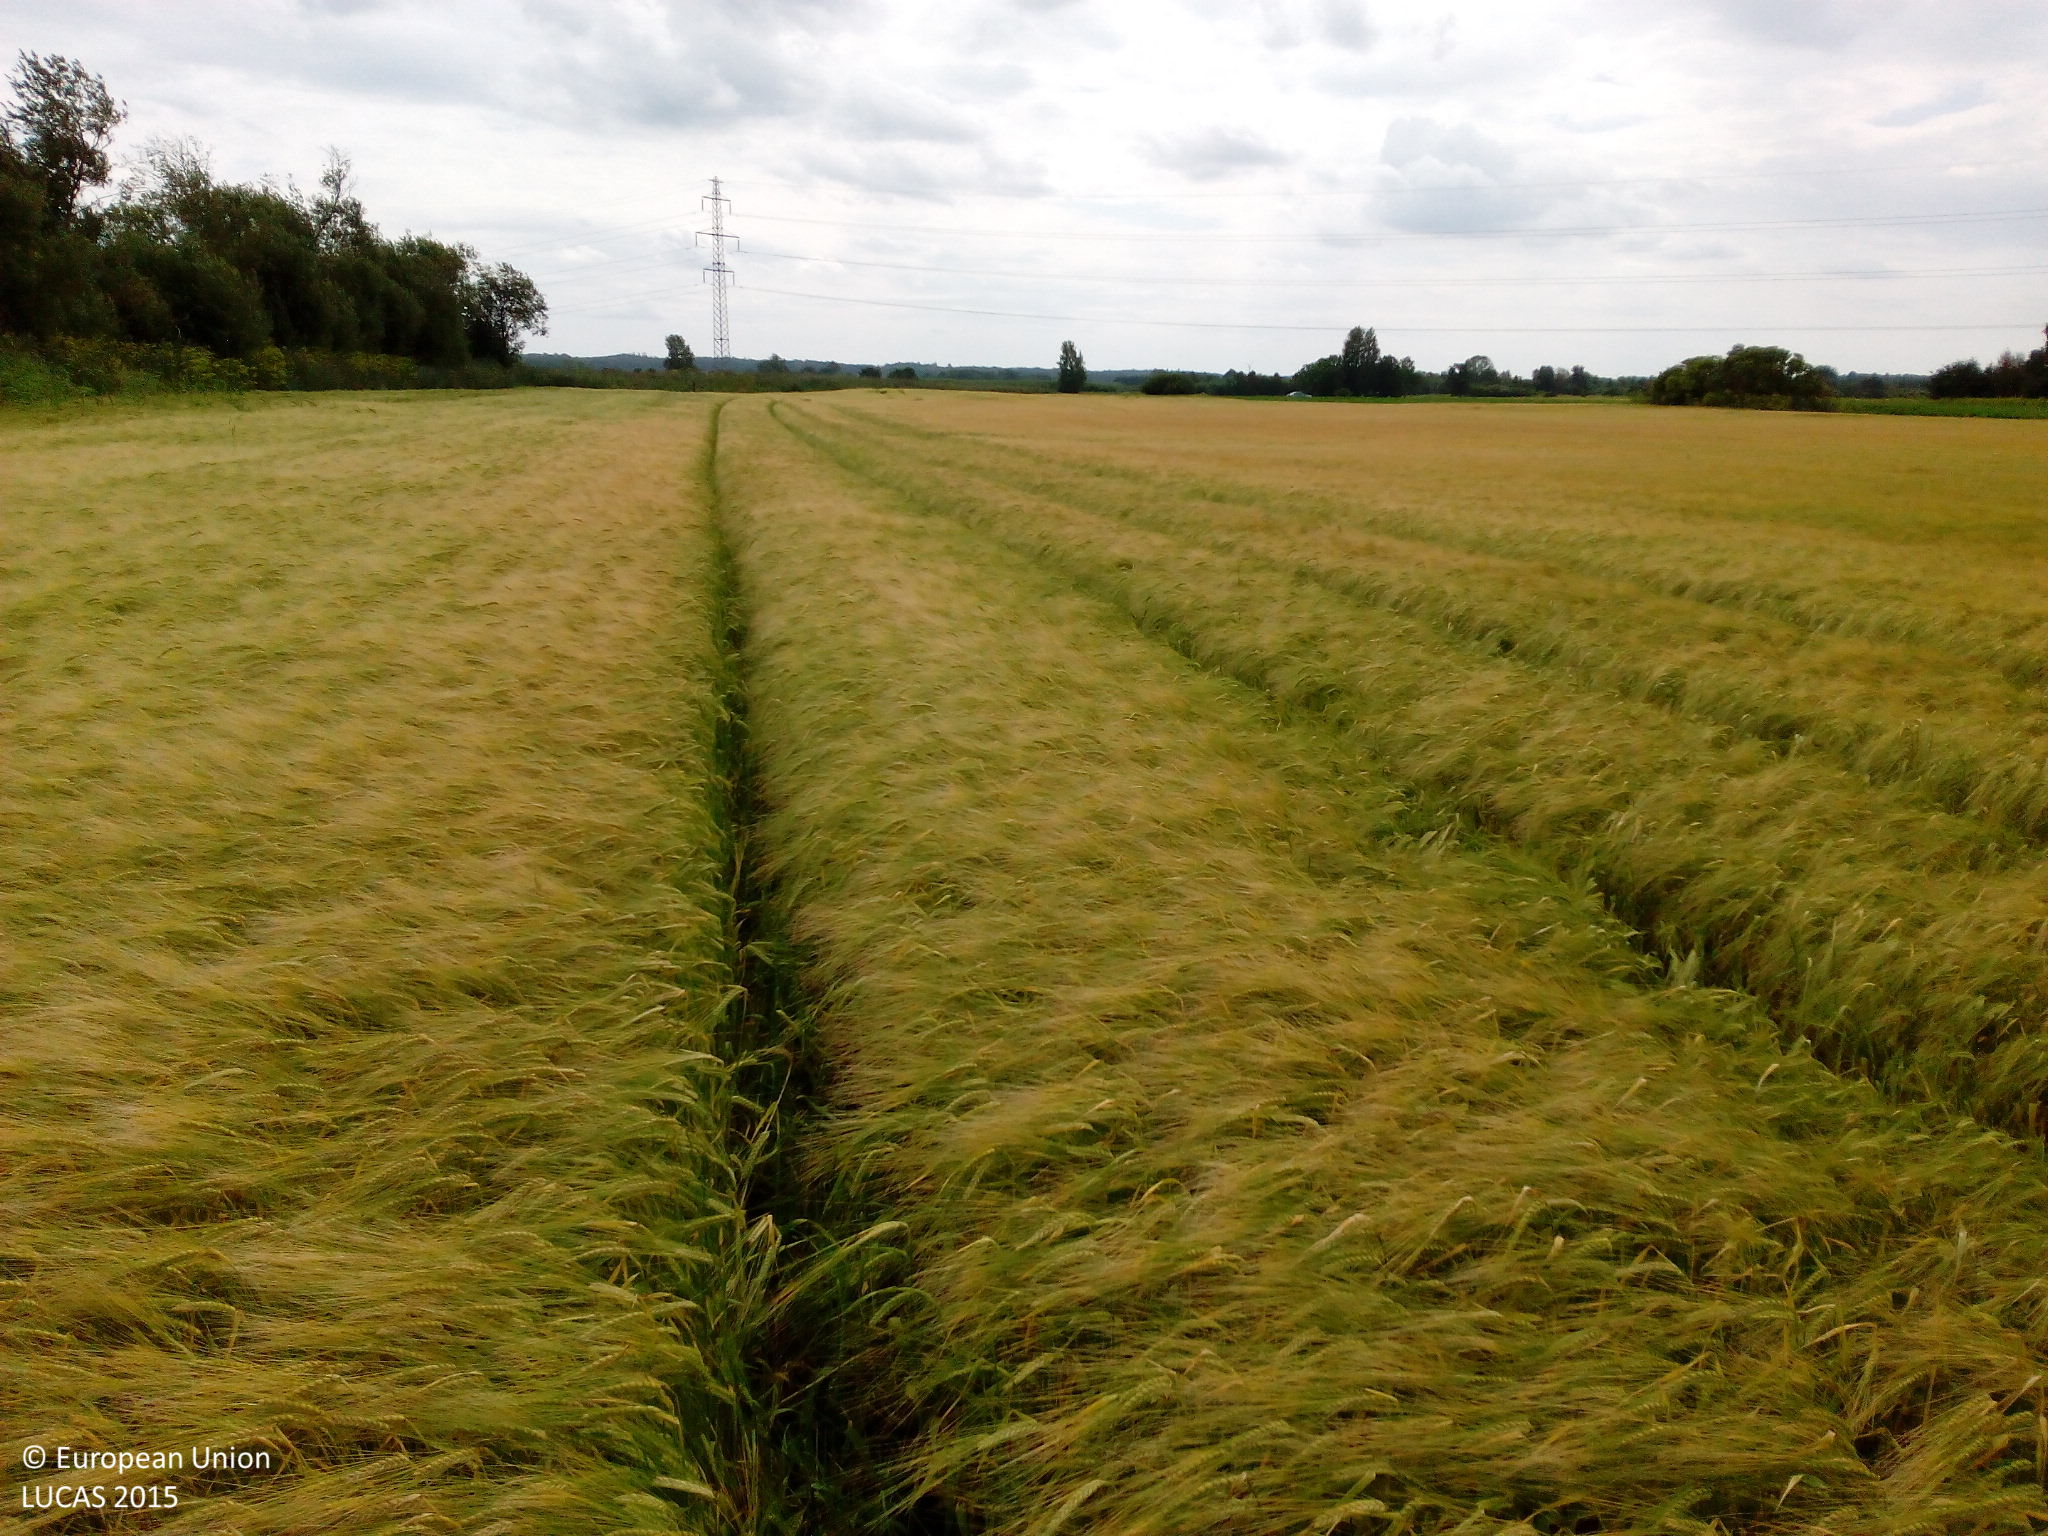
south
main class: Cropland
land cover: Barley
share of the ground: > 75 %
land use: Agriculture (excluding fallow land and kitchen gardens)
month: July
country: DK
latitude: 55.6931
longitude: 11.5417
